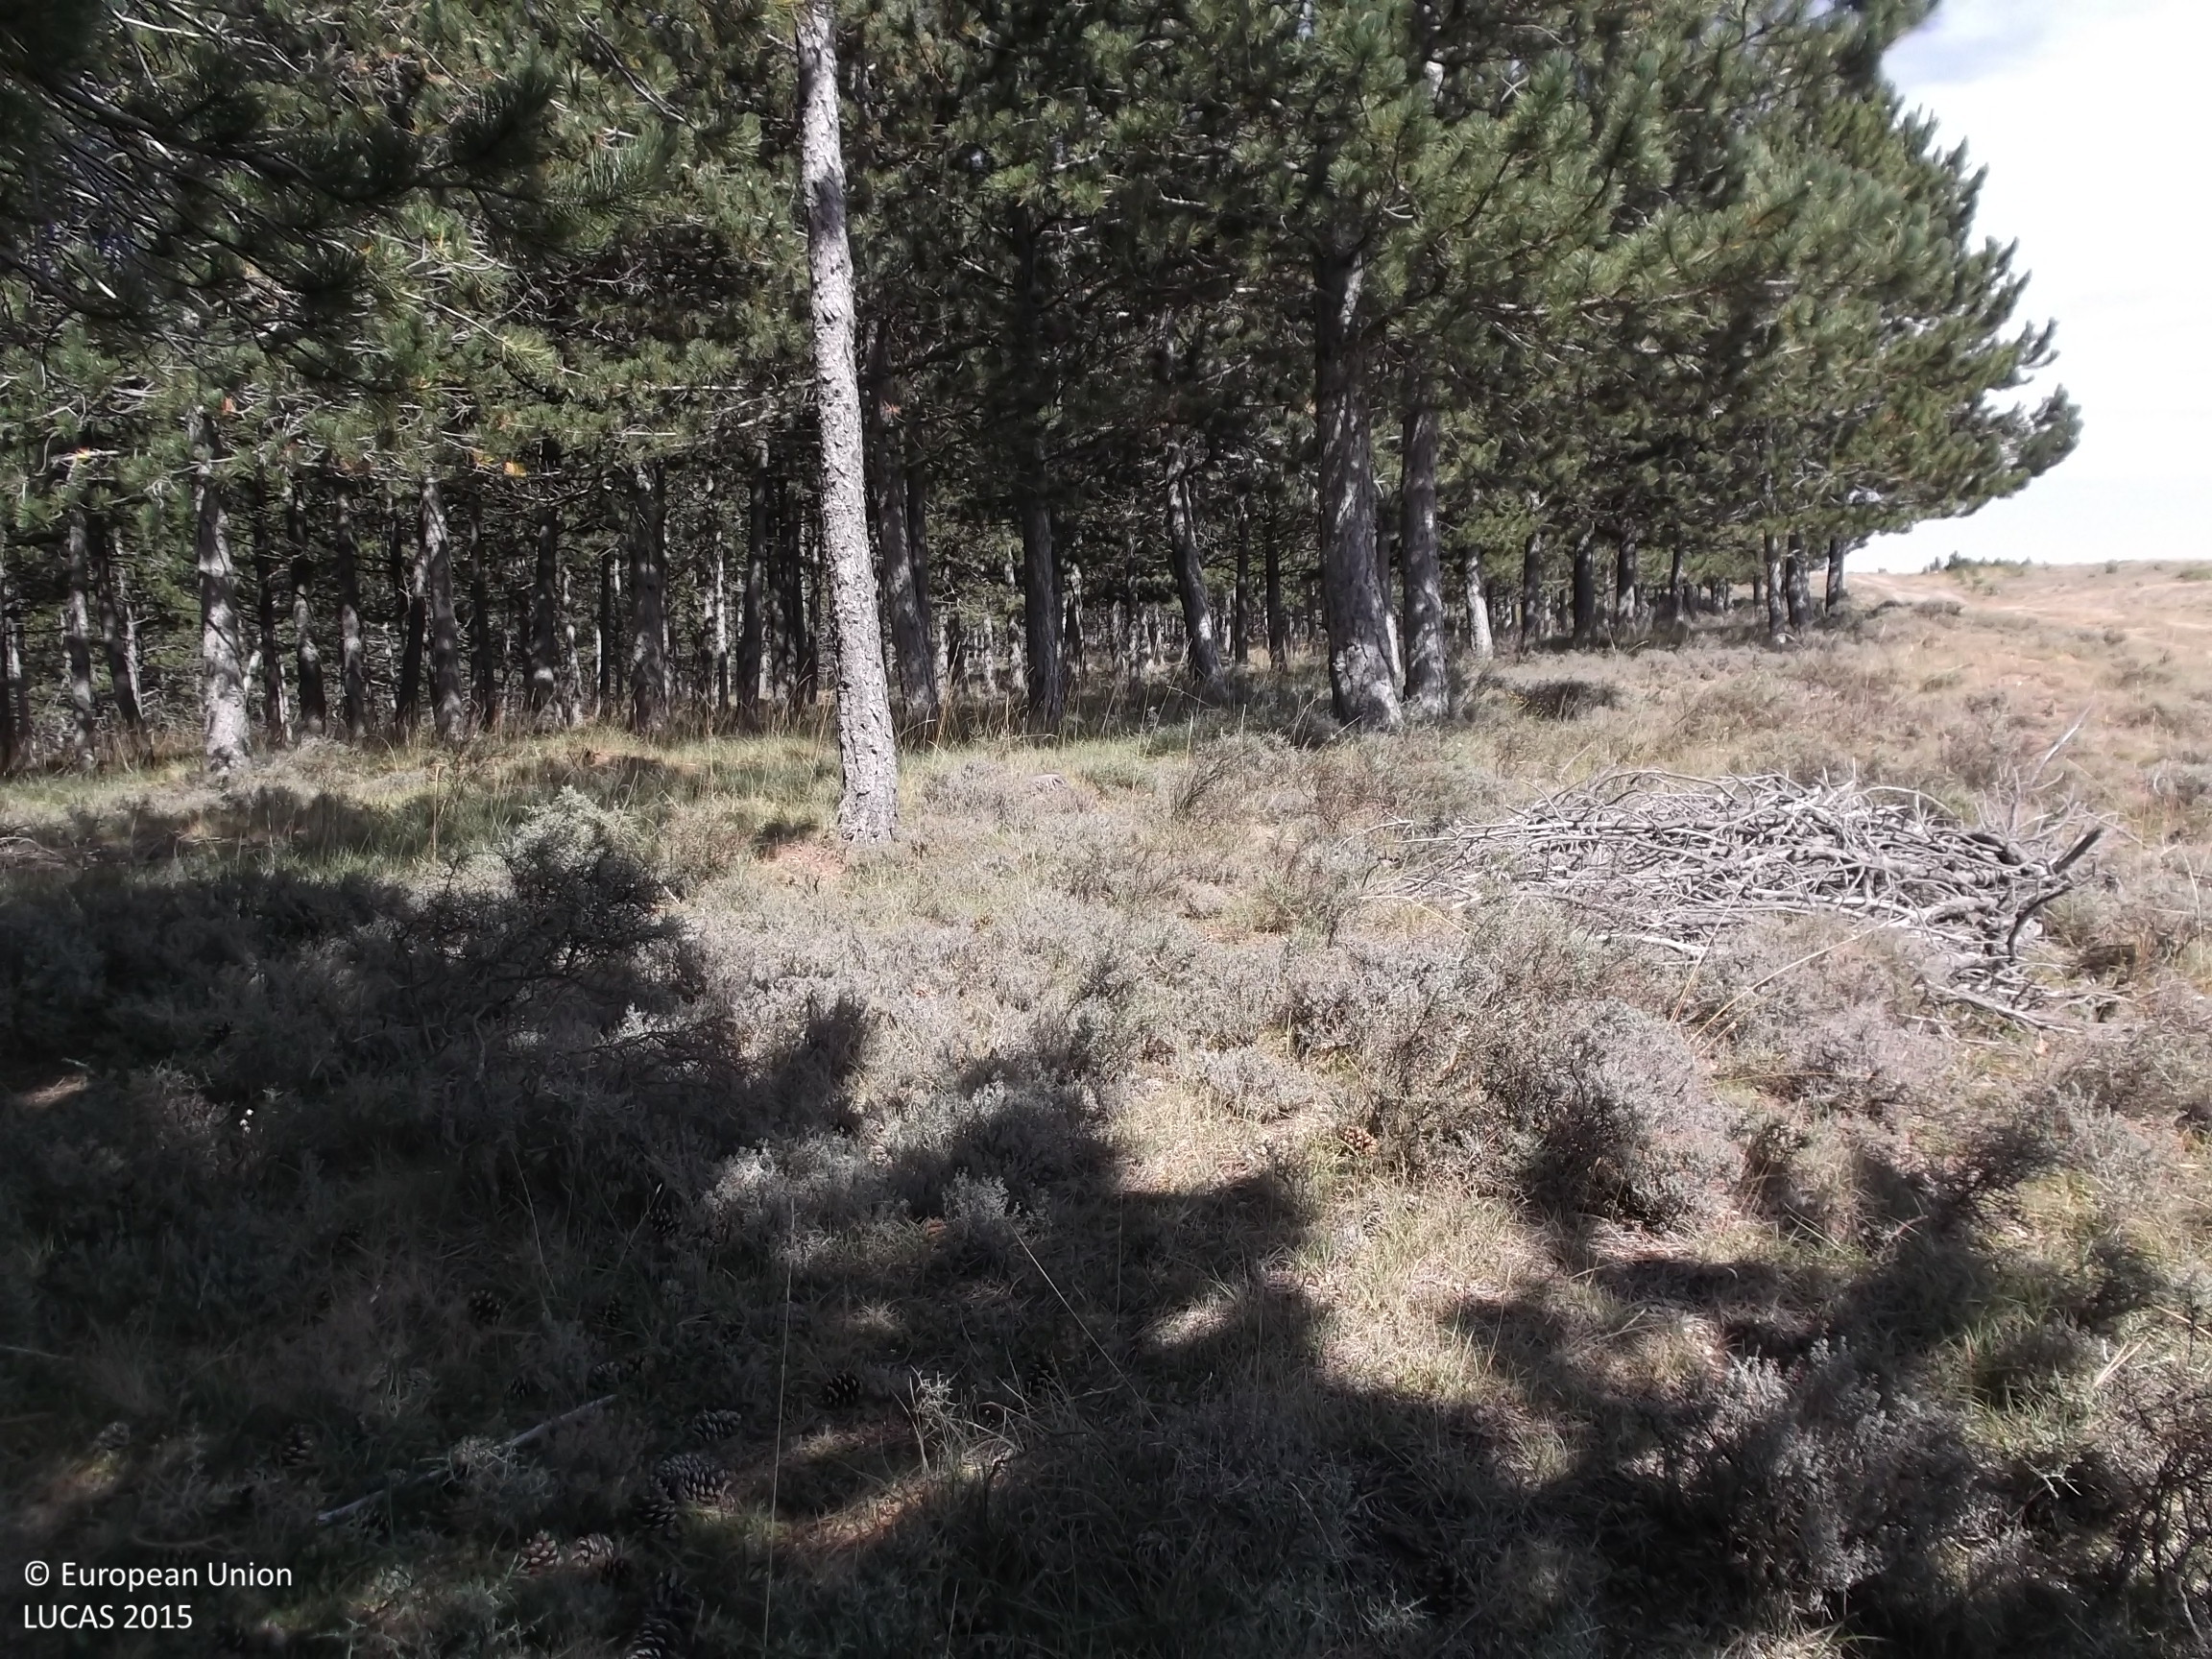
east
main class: Woodland
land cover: Pine dominated coniferous woodland
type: coniferous forest of the mediterranean region
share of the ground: > 75 %
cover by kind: coniferous forest trees 80 %, herbaceous plants 15 %, shrubs 5 %
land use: Forestry
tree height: > 5 m
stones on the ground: < 10 %
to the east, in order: Pine dominated coniferous woodland
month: July
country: ES
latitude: 42.0441
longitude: -2.3257
